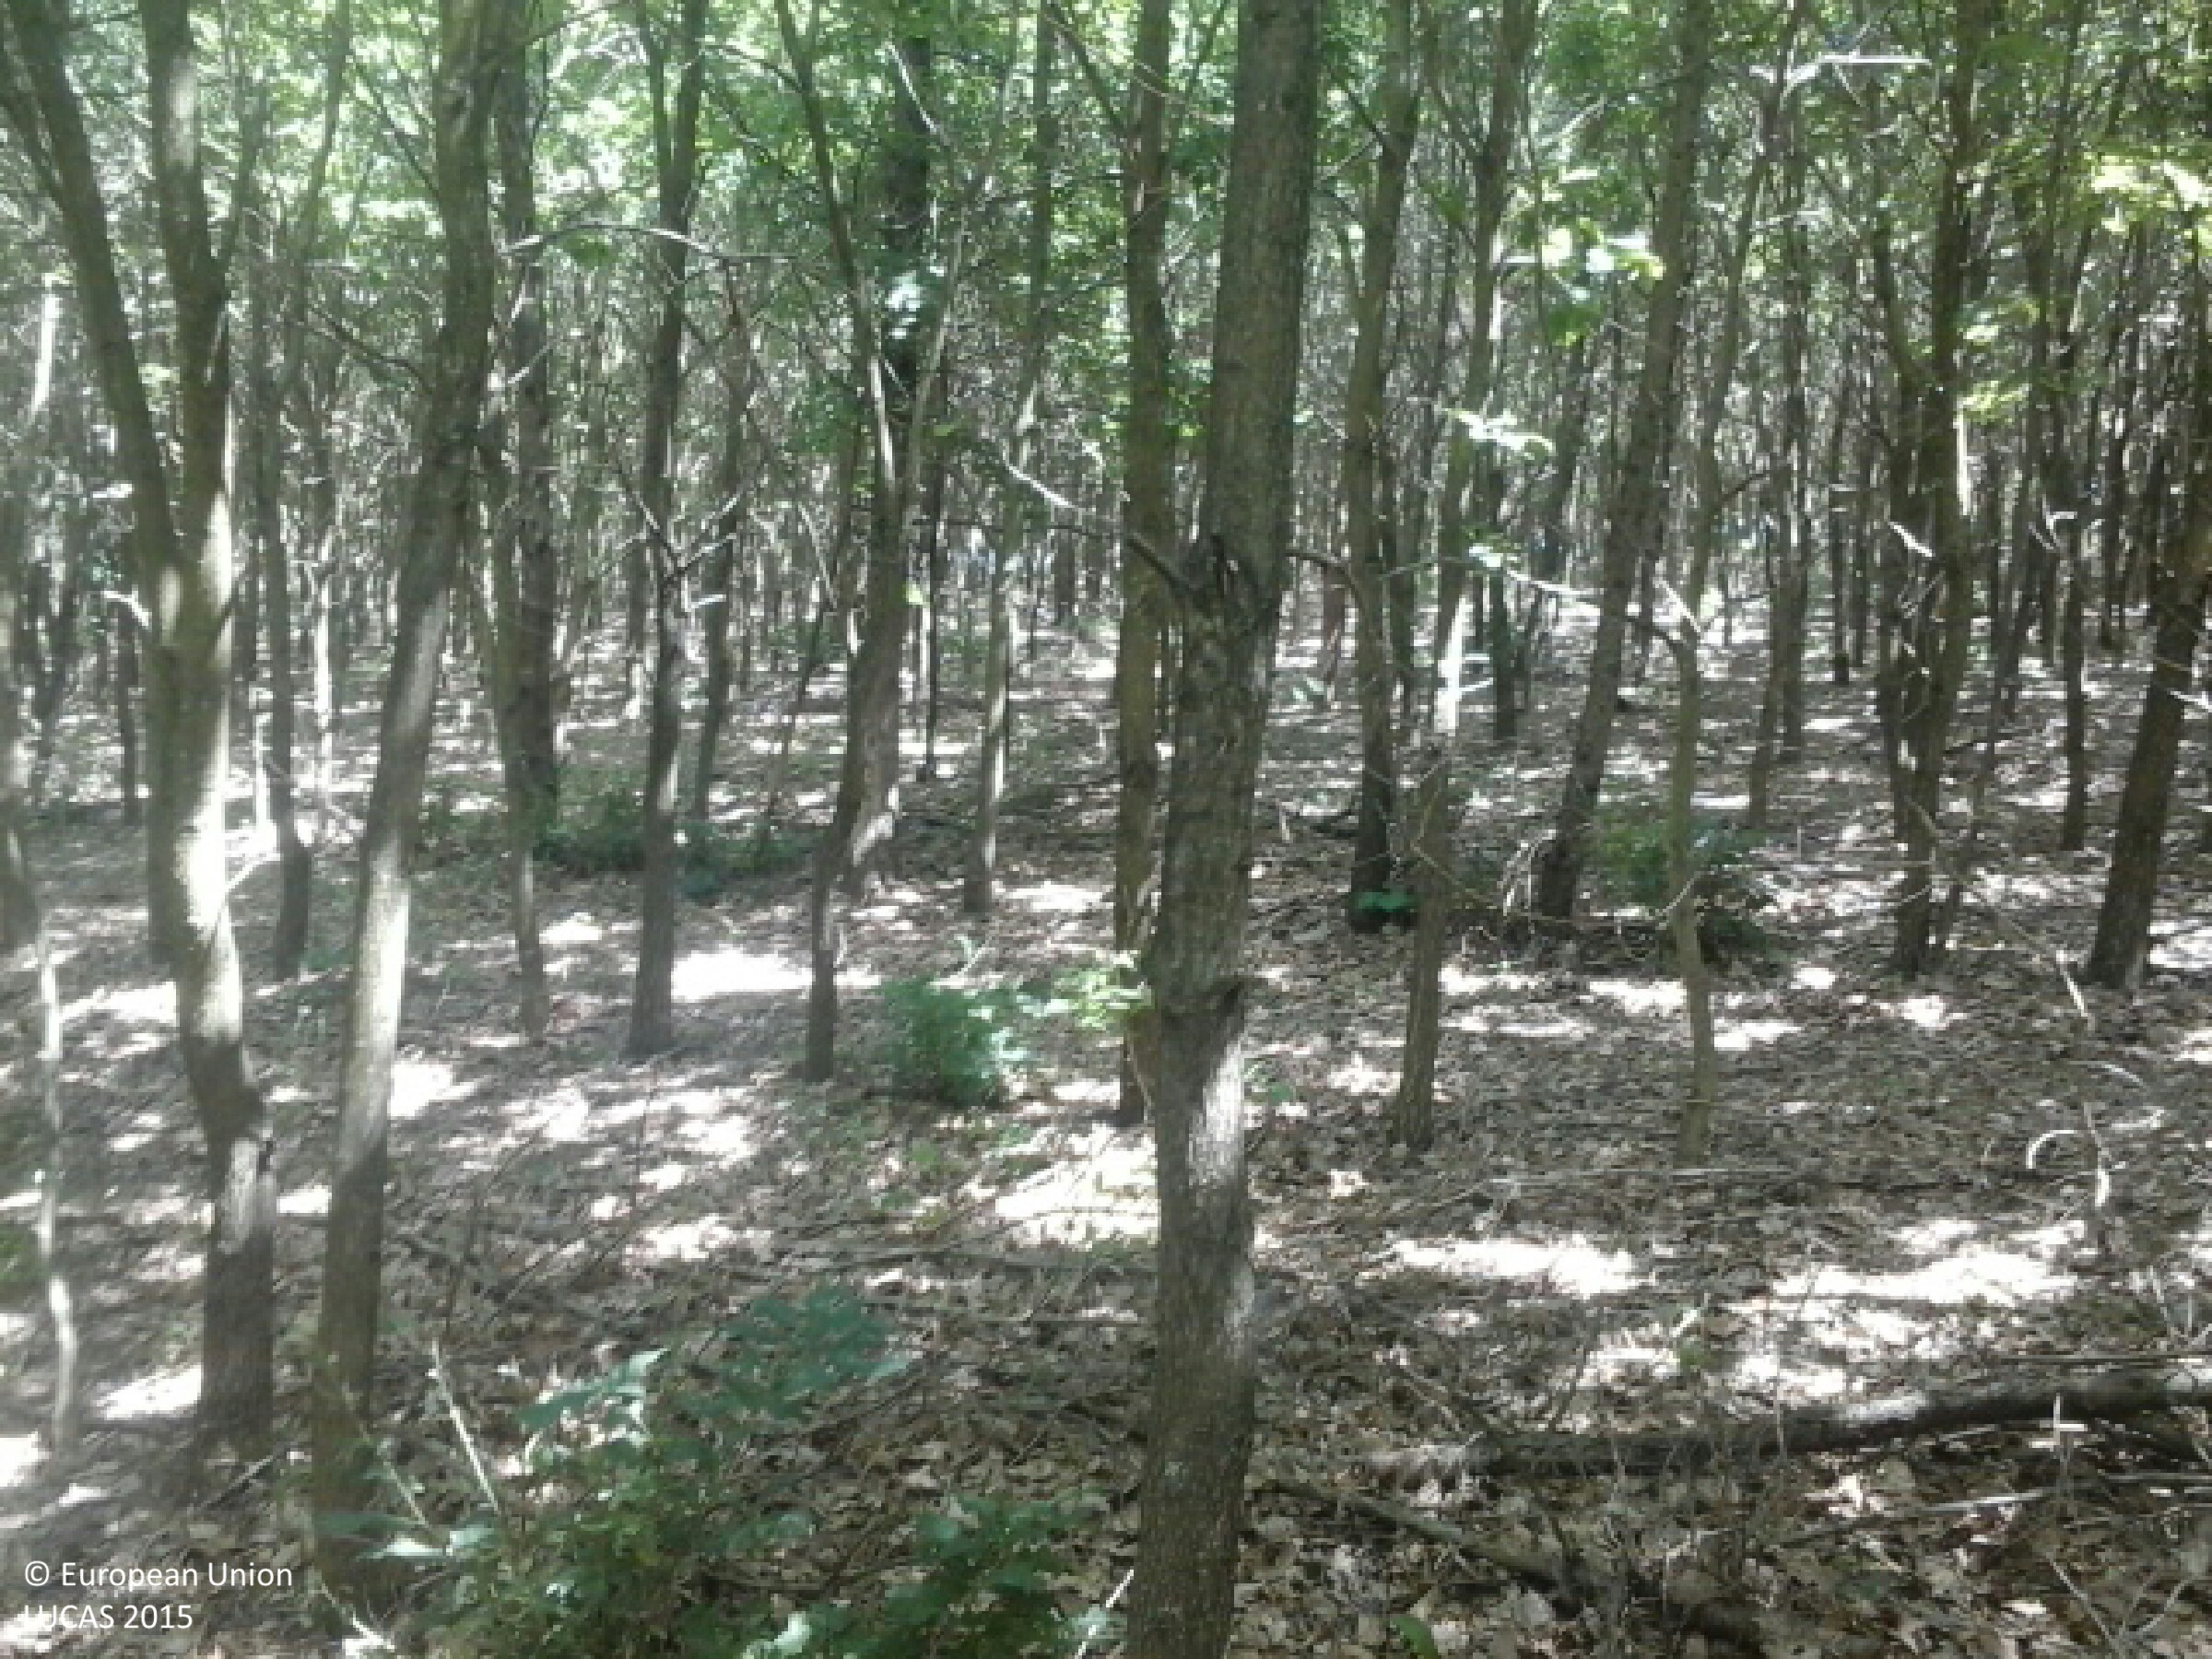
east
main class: Woodland
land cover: Broadleaved woodland
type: mesophytic deciduous forest
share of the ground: > 75 %
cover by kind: broadleaved forest trees 95 %, coniferous forest trees 5 %
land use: Forestry
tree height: > 5 m
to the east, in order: Broadleaved woodland; Ditches and canals; Abandoned hedges; Grassland with sparse tree/shrub cover
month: July
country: HU
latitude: 48.4442
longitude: 21.6069
